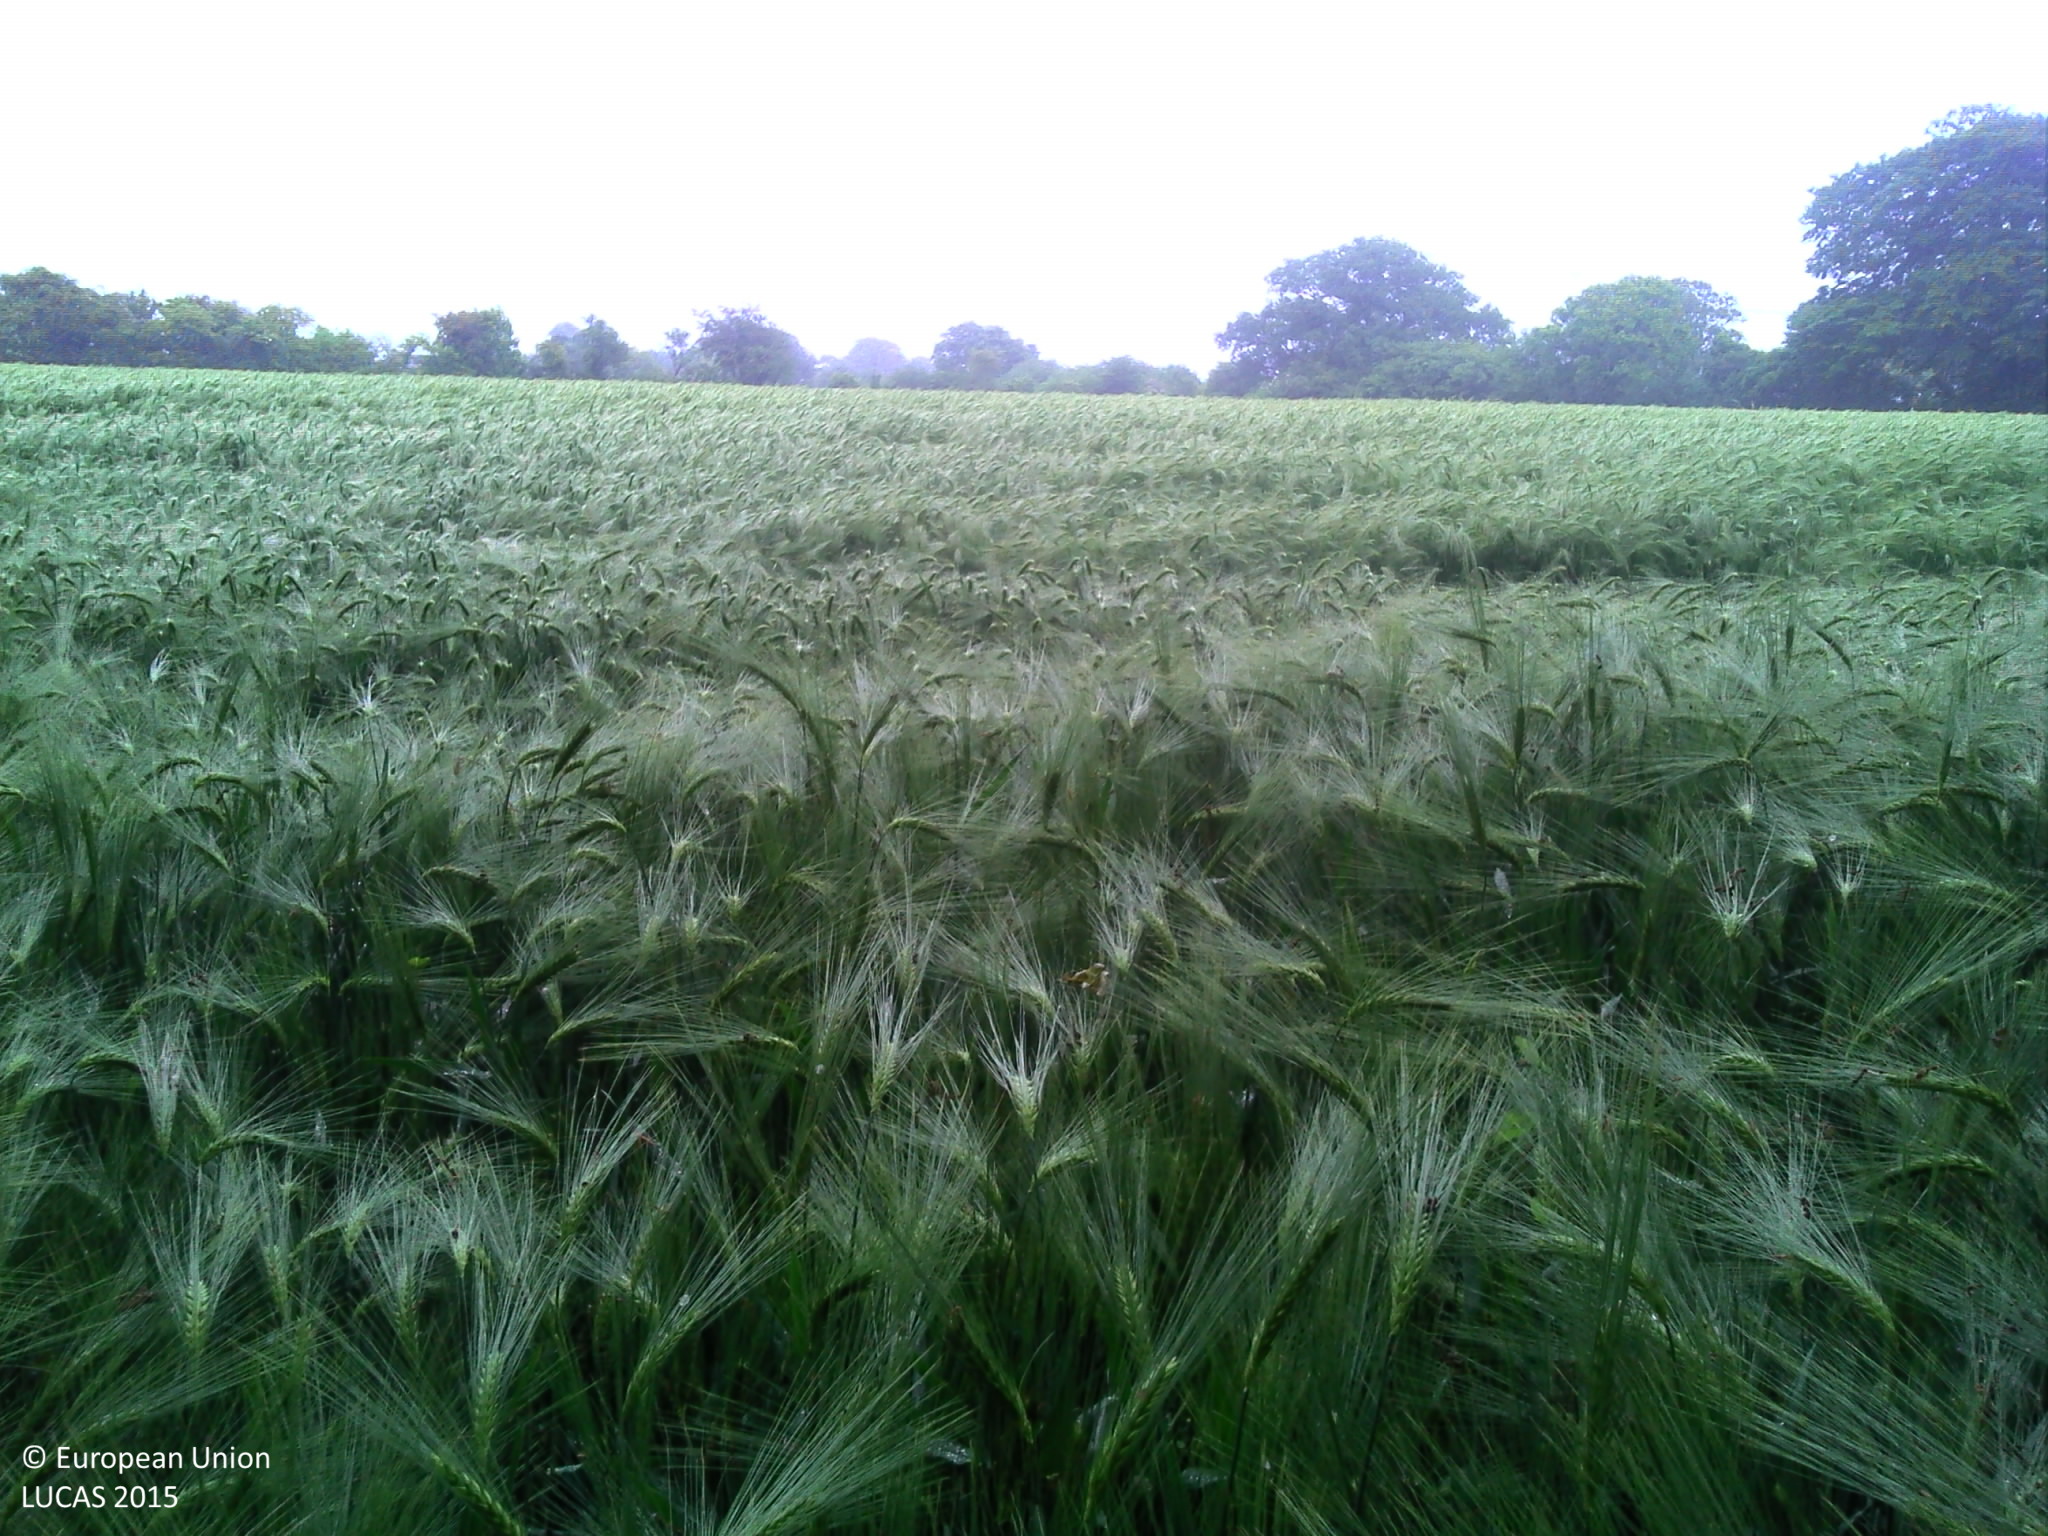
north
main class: Cropland
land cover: Barley
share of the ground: > 75 %
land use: Agriculture (excluding fallow land and kitchen gardens)
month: June
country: FR
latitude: 49.5251
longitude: -1.6983
